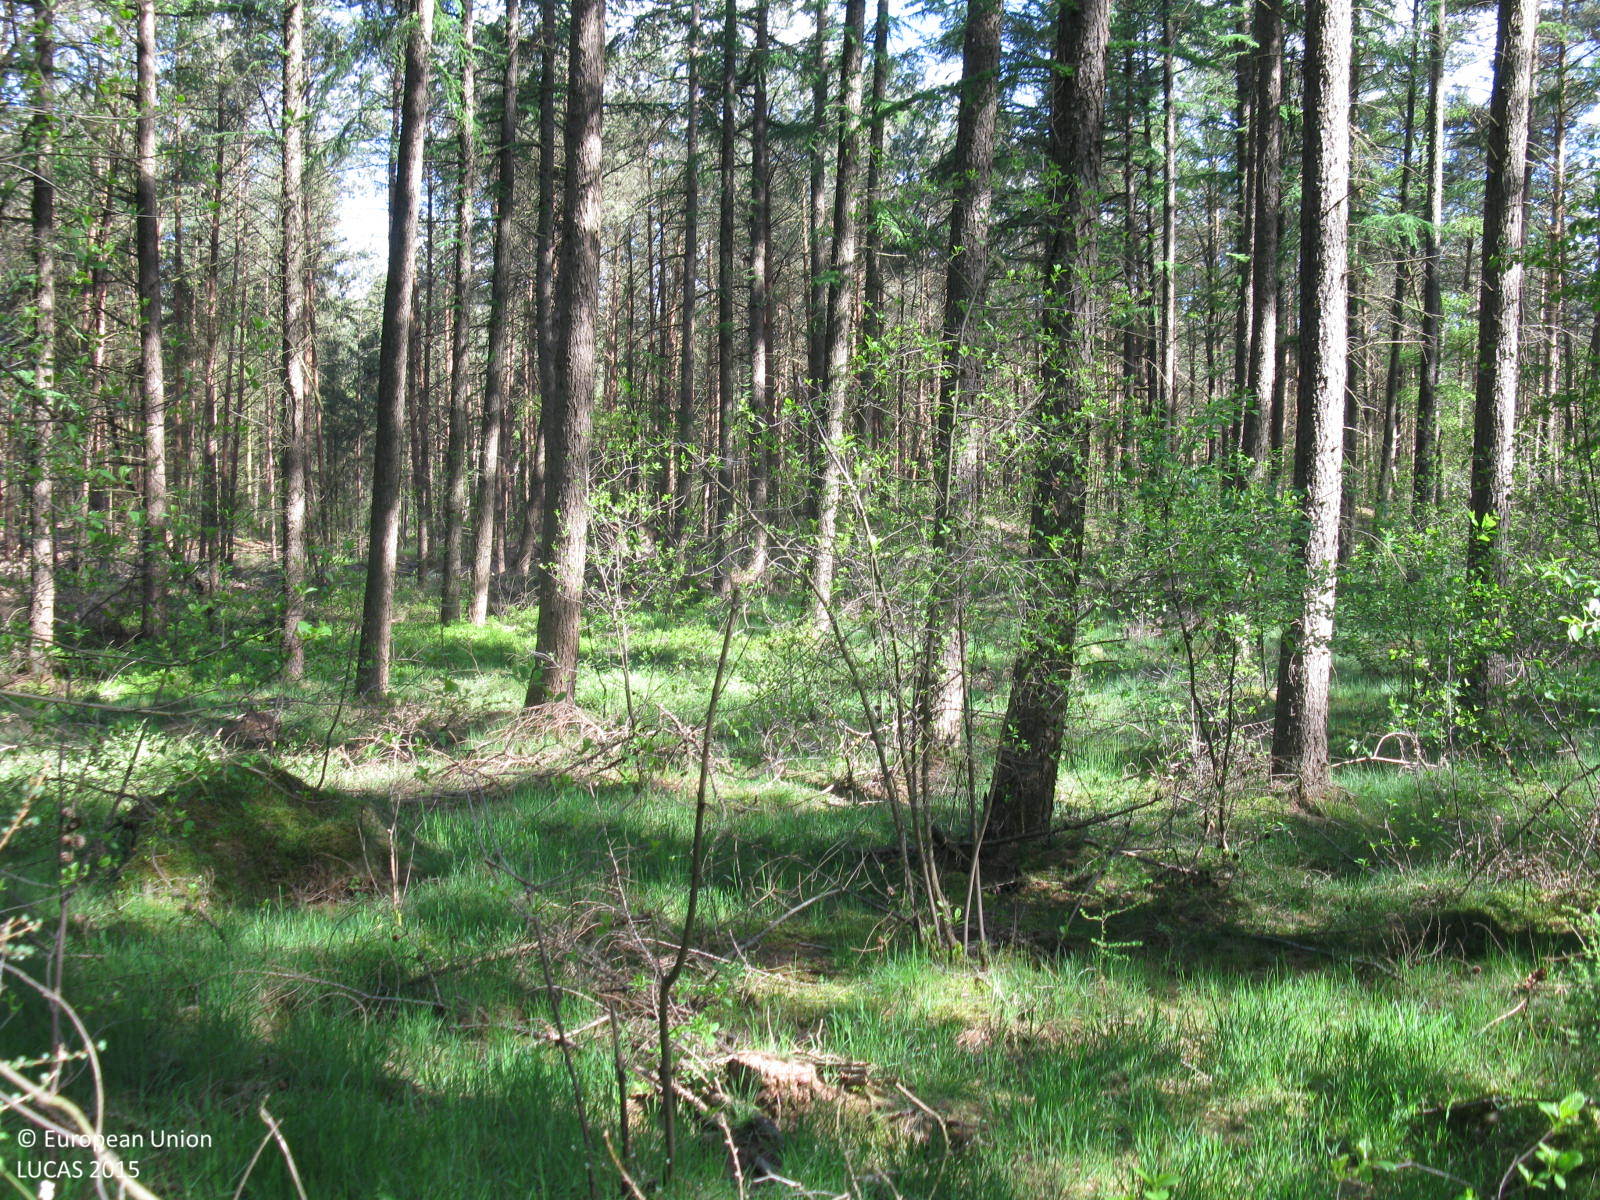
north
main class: Woodland
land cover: Other coniferous woodland
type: hemiboreal forest and nemoral coniferous forest and mixed broadleaved-coniferous forest
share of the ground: > 75 %
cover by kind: coniferous forest trees 100 %
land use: Forestry
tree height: > 5 m
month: May
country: DE
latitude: 52.8147
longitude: 7.3149
